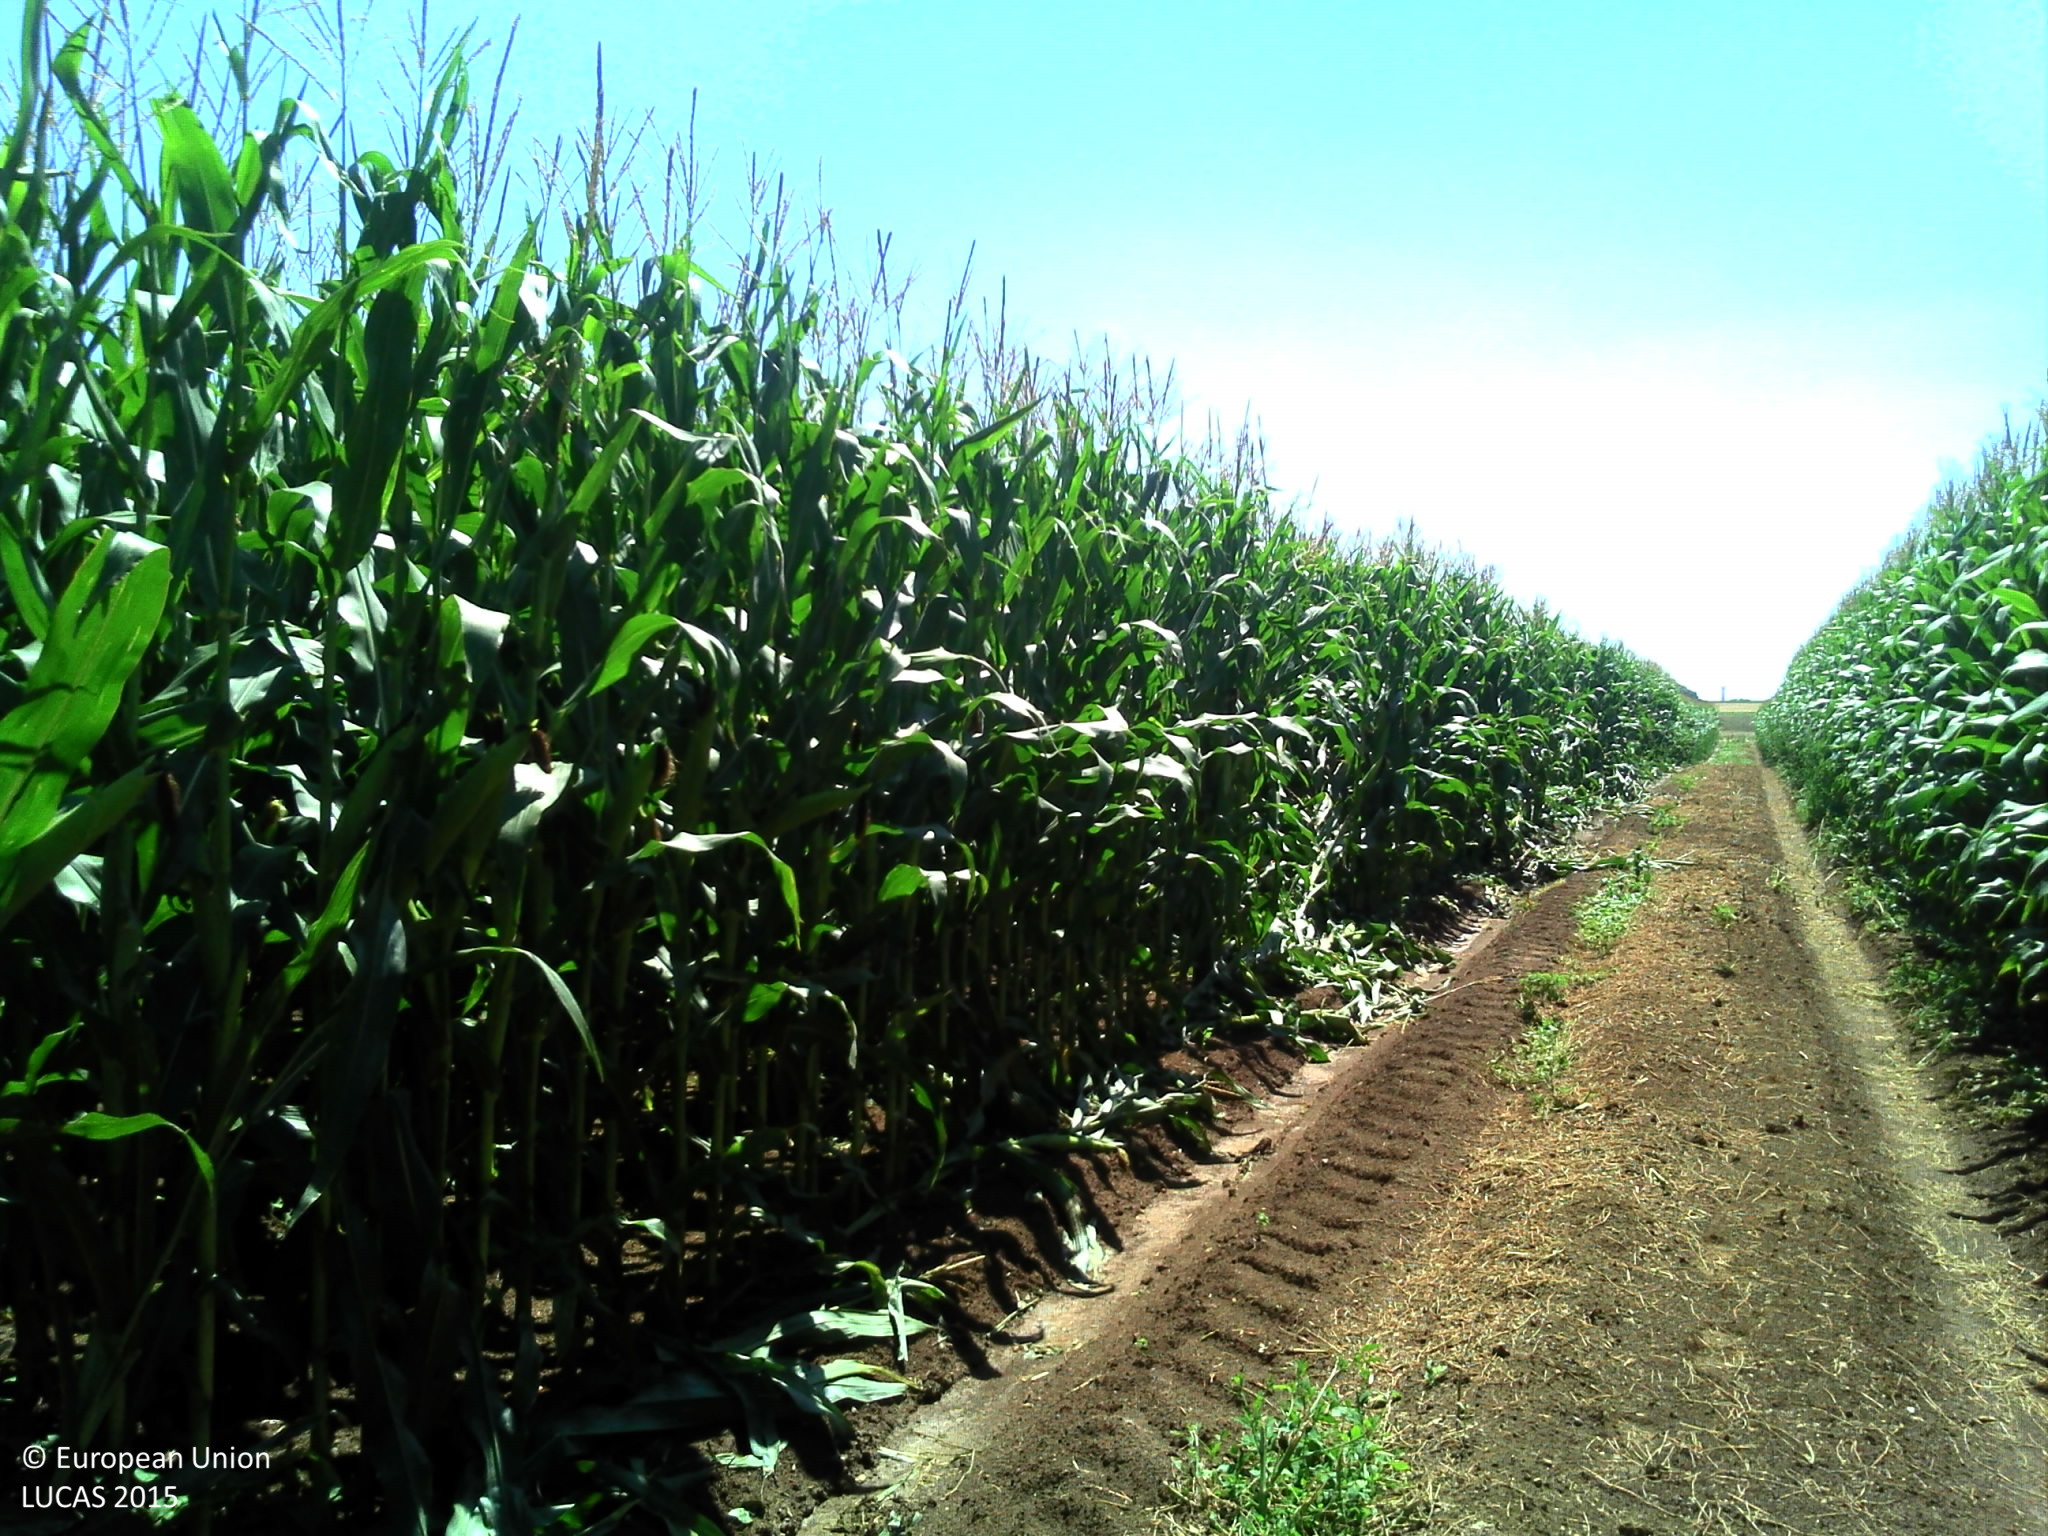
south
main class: Cropland
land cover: Maize
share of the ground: > 75 %
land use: Agriculture (excluding fallow land and kitchen gardens)
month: August
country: FR
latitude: 48.1845
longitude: 1.9841
